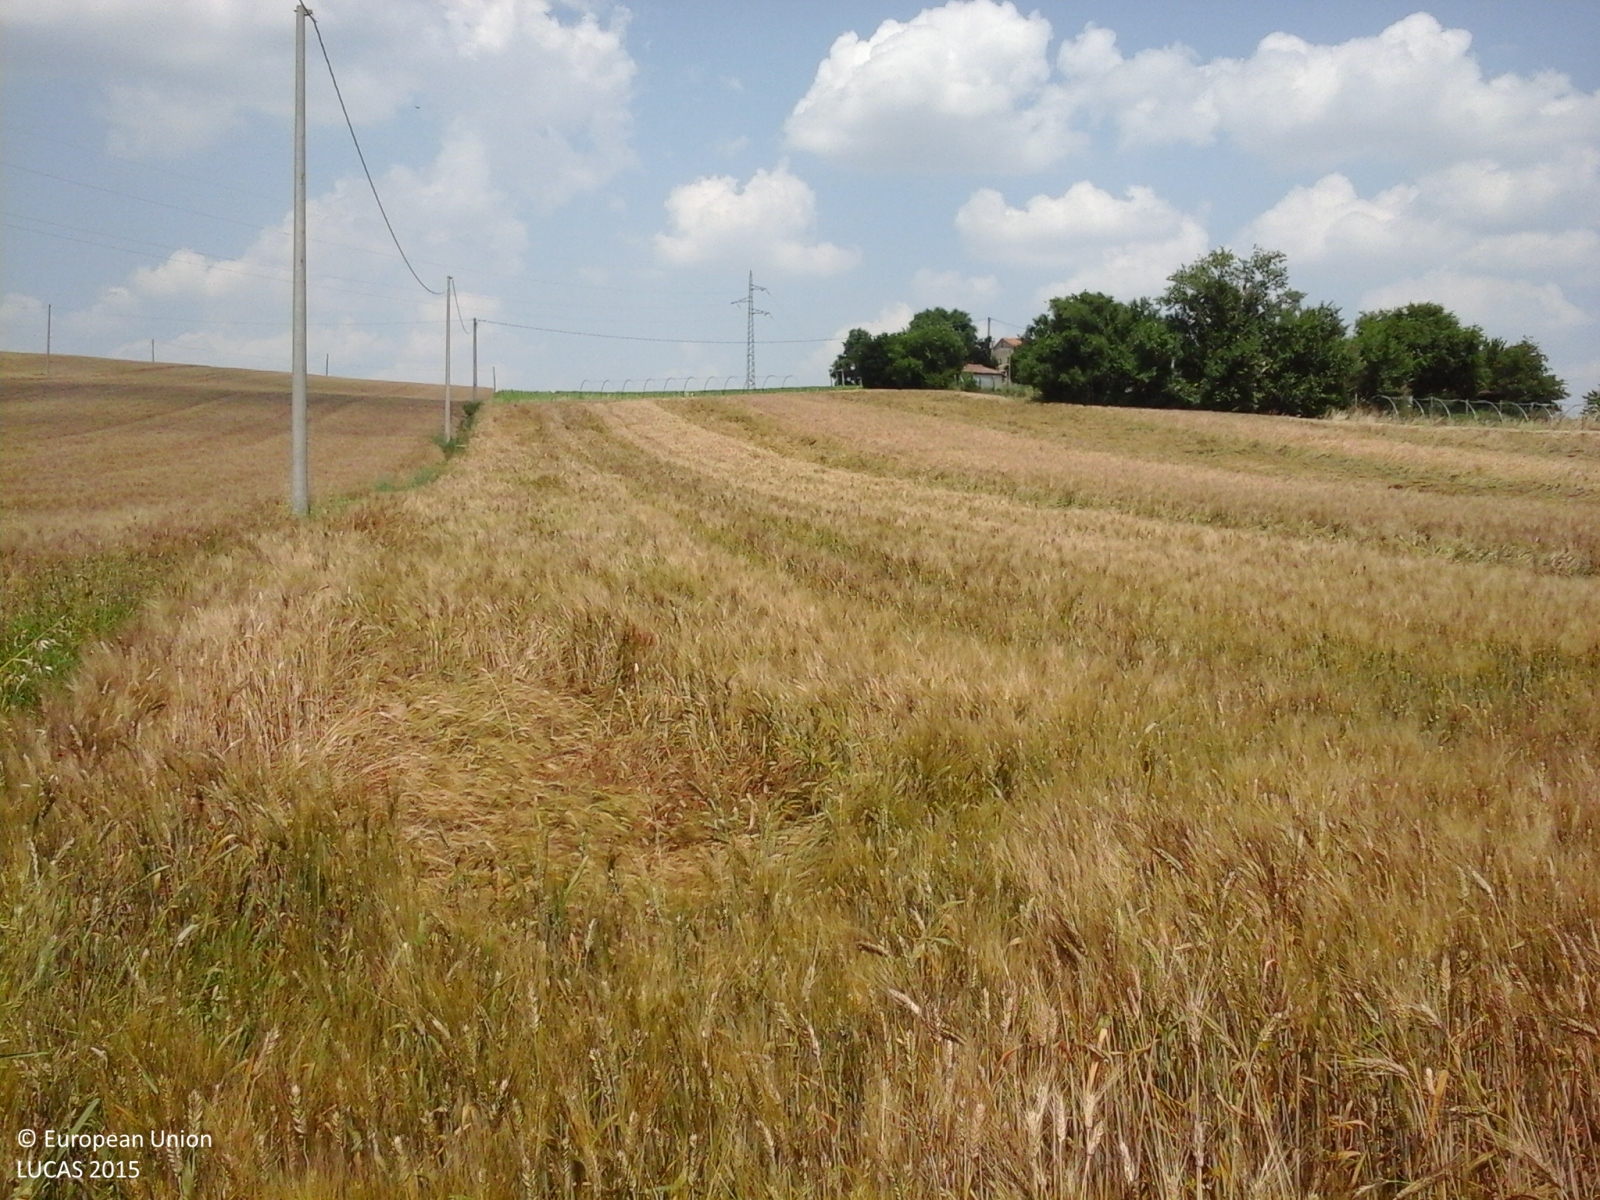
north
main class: Cropland
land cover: Durum wheat
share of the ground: > 75 %
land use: Agriculture (excluding fallow land and kitchen gardens)
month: June
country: IT
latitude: 43.2294
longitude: 13.4017
